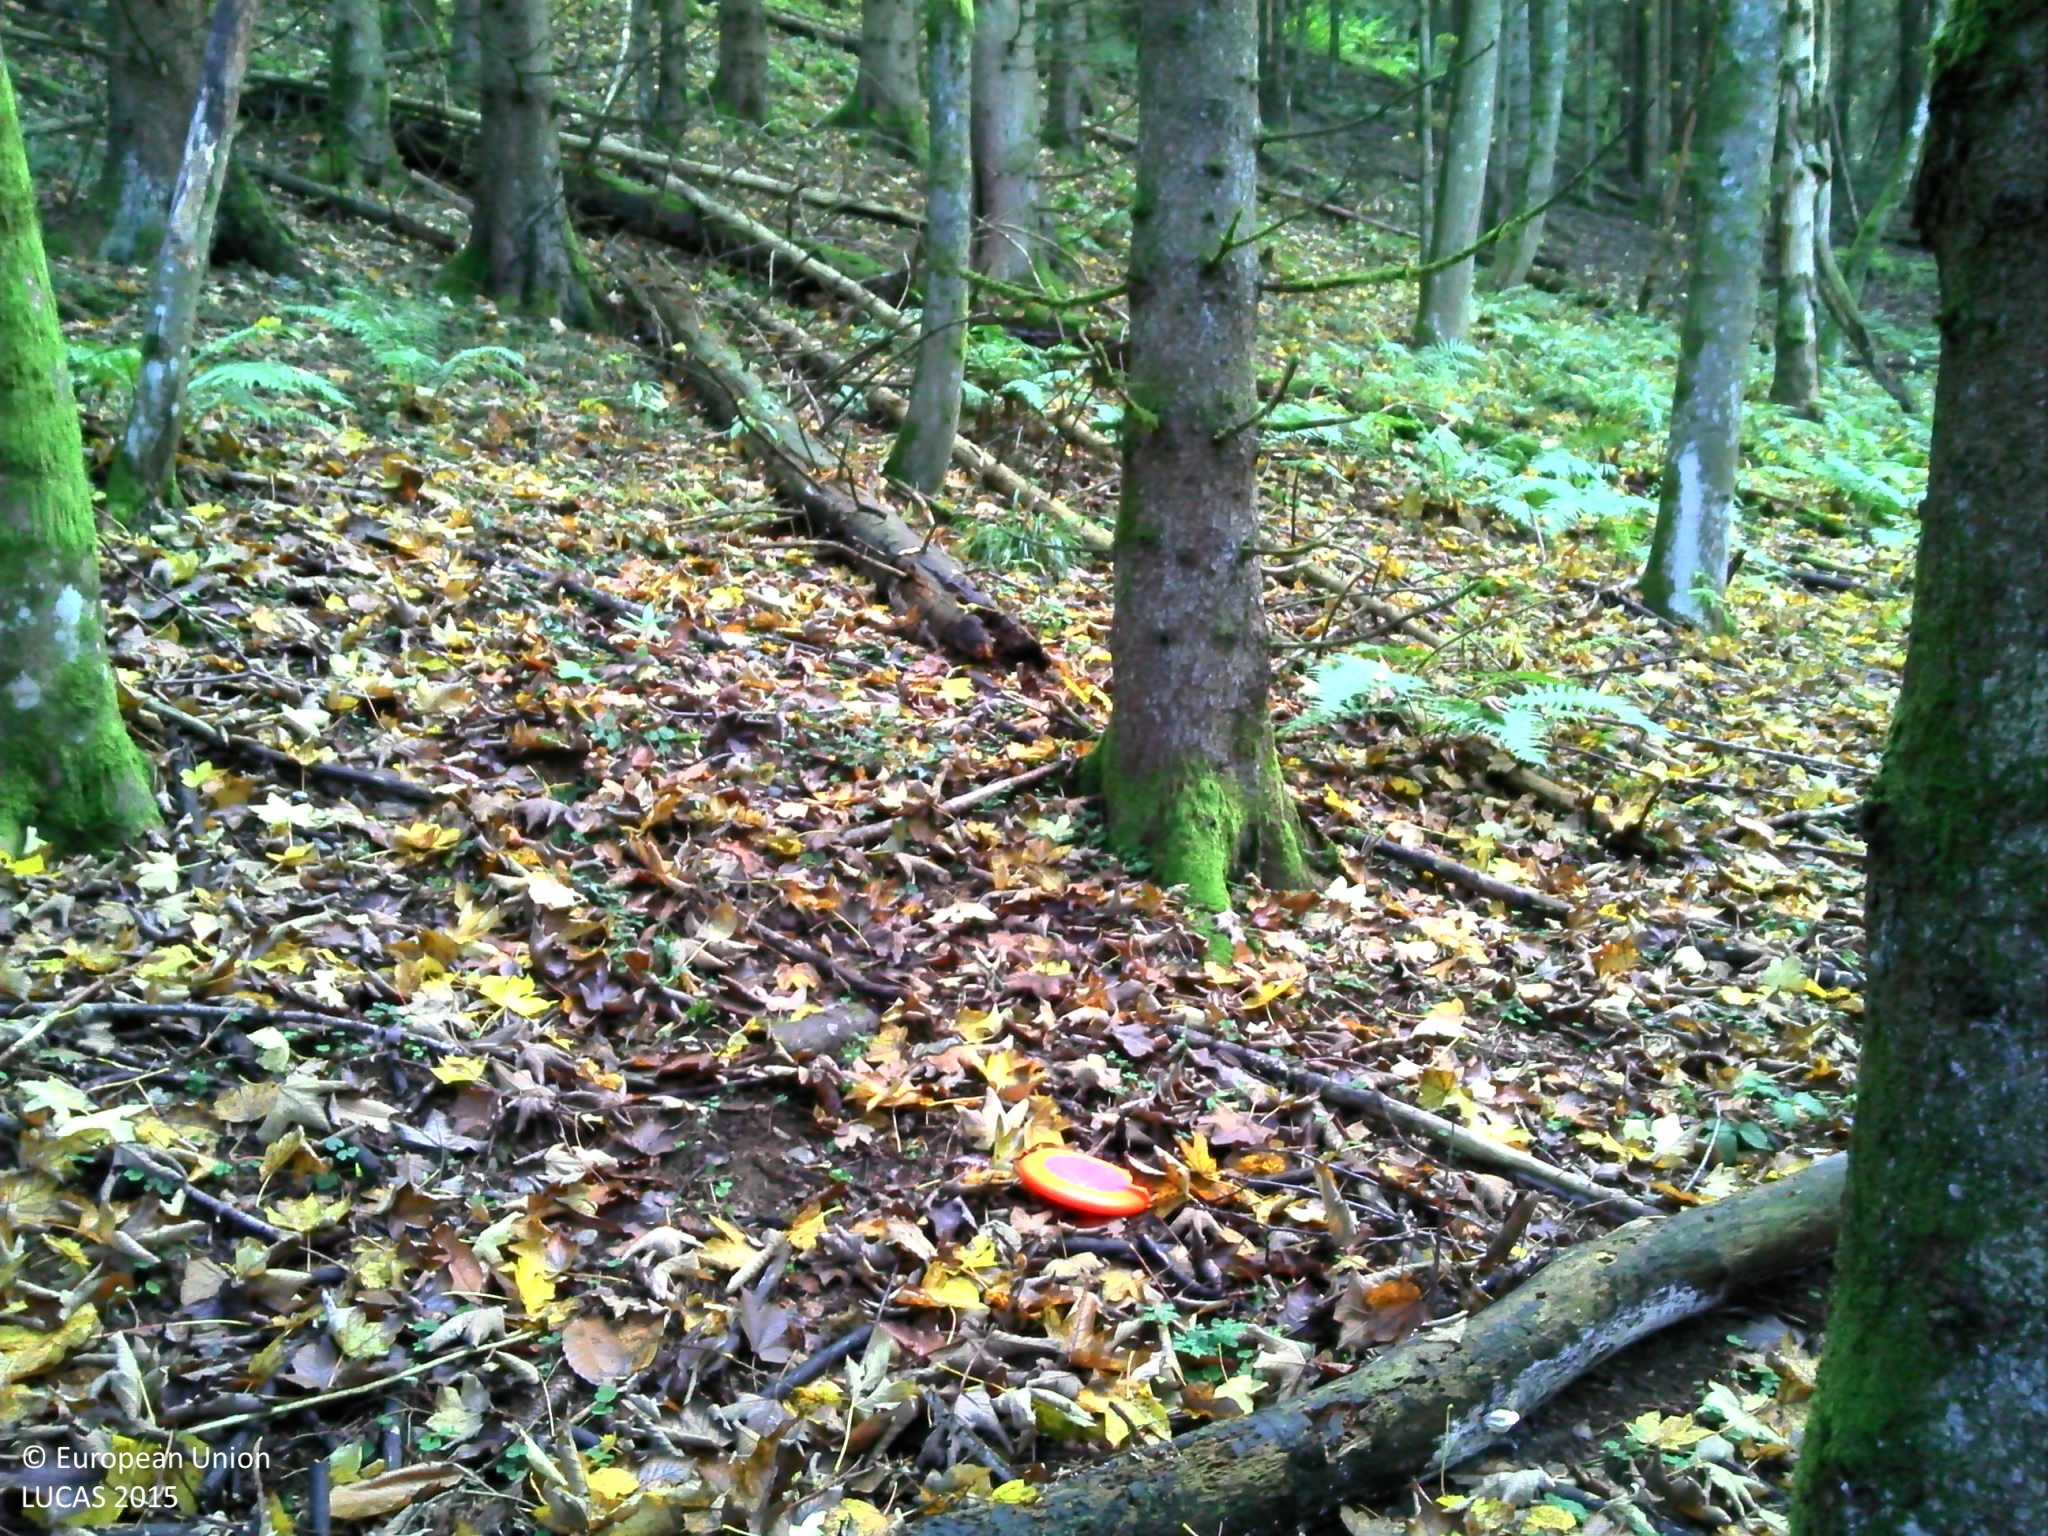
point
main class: Woodland
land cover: Spruce dominated mixed woodland
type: hemiboreal forest and nemoral coniferous forest and mixed broadleaved-coniferous forest
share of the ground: > 75 %
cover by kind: coniferous forest trees 50 %, broadleaved forest trees 35 %, unconsolidated bare surface 15 %
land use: Forestry
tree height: > 5 m
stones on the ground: < 10 %
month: October
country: FR
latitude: 45.4562
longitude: 6.2579
